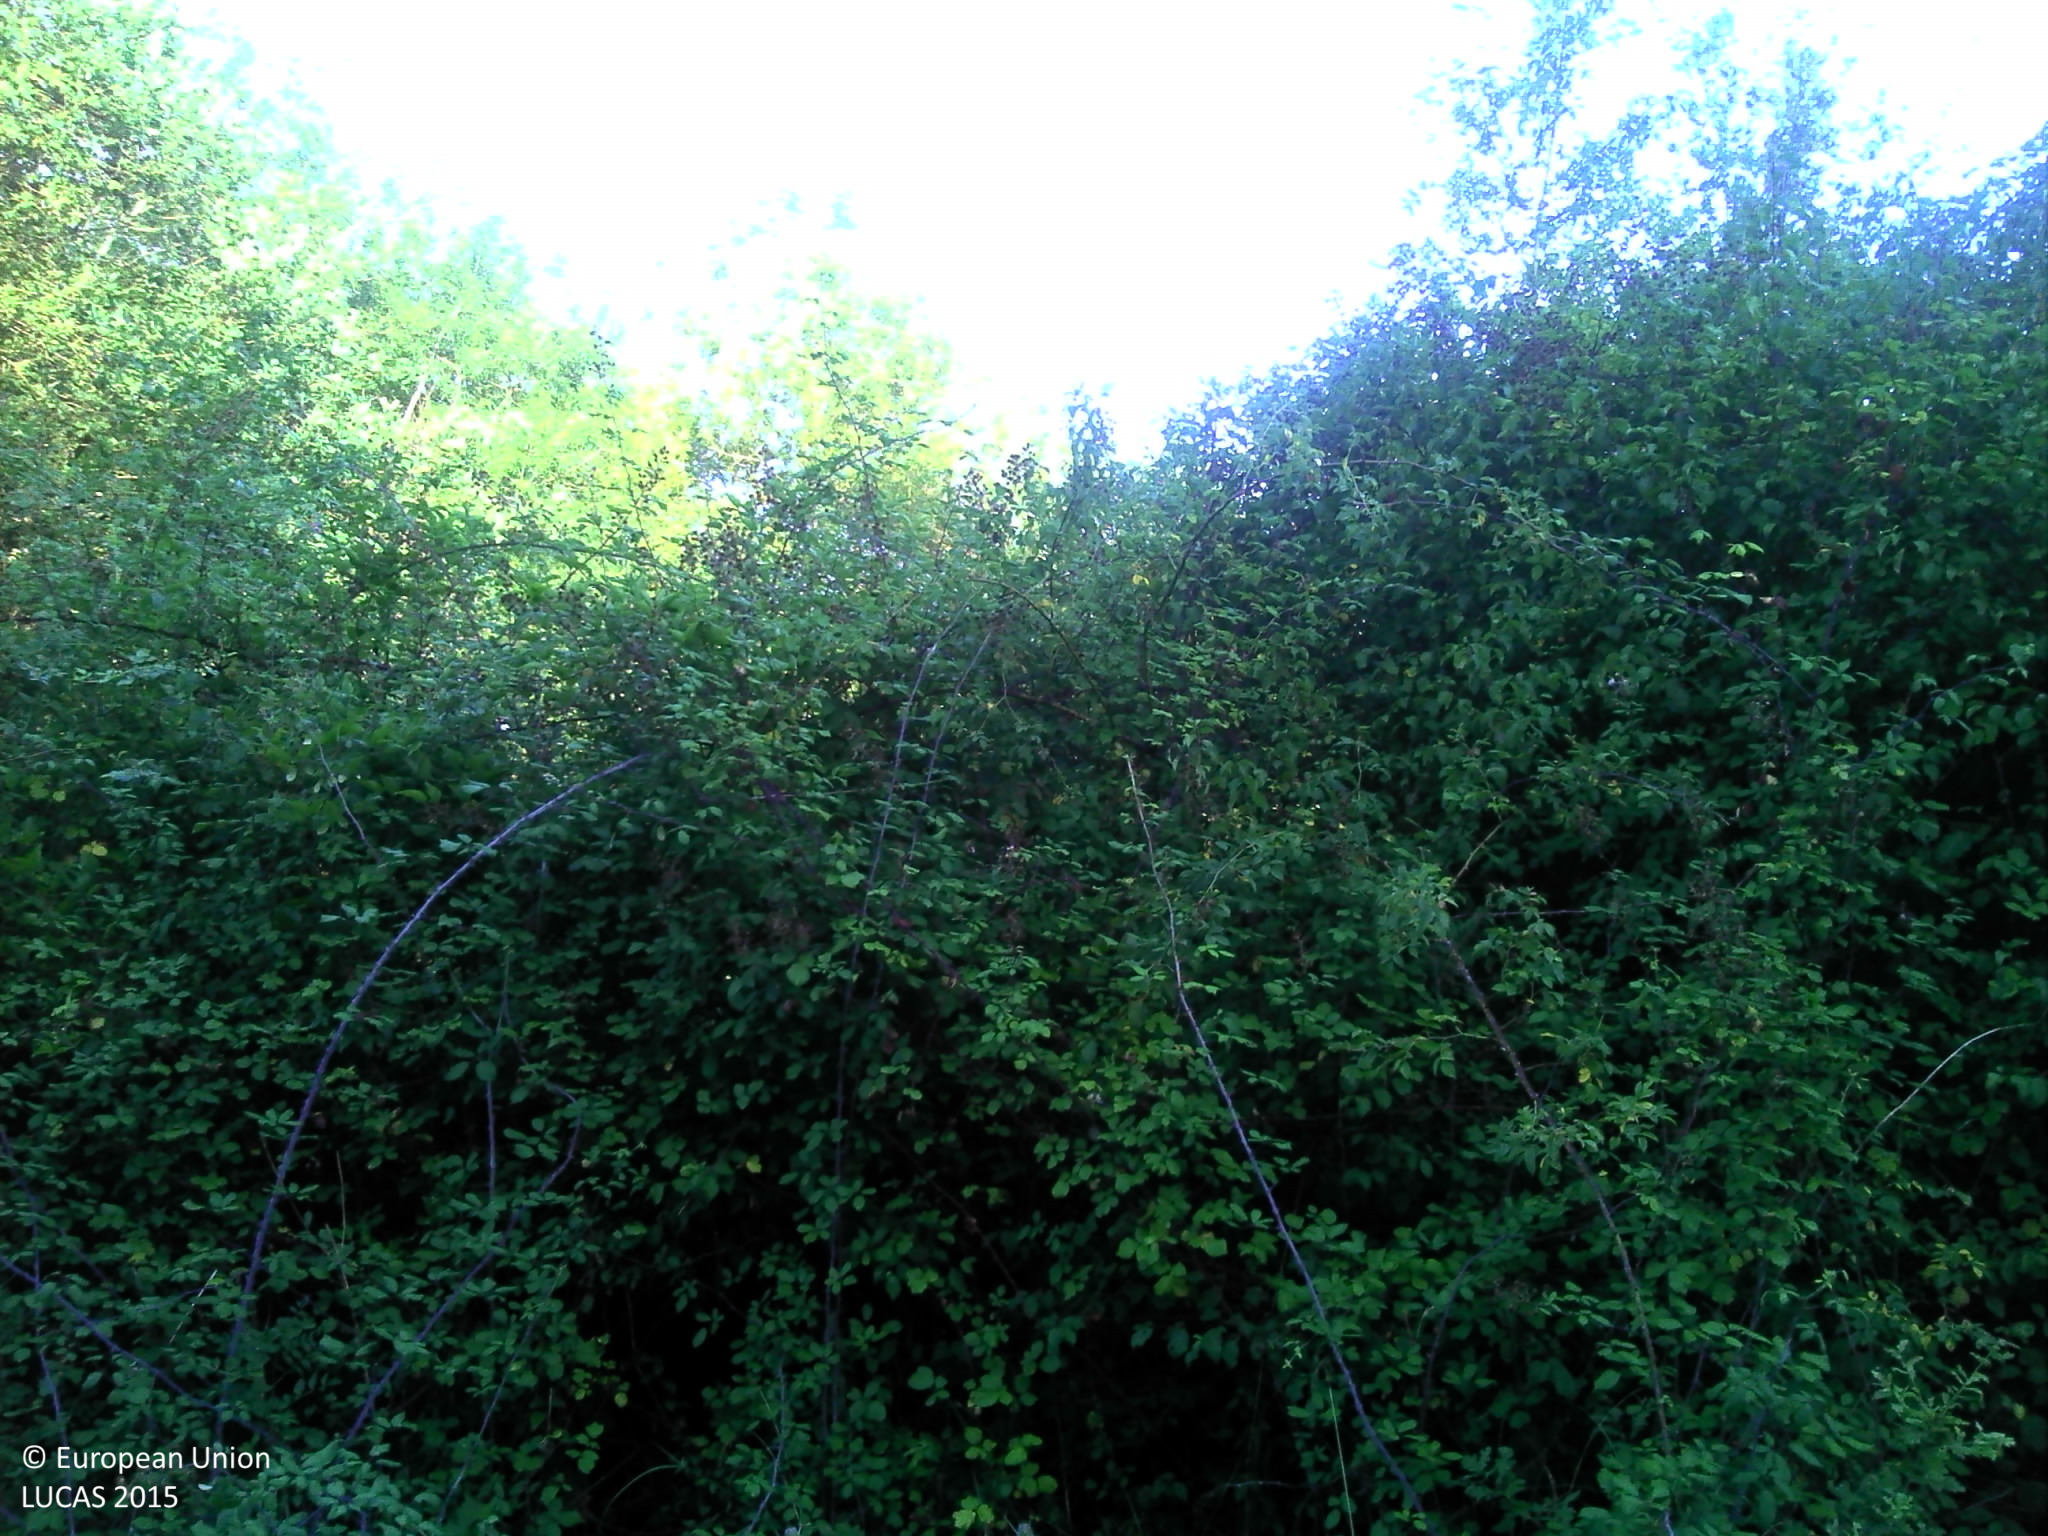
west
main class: Woodland
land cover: Broadleaved woodland
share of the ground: > 75 %
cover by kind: broadleaved forest trees 85 %, herbaceous plants 10 %, lichens and mosses 5 %
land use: Semi-natural and natural areas not in use
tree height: > 5 m
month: July
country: FR
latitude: 43.6784
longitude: -1.1177
